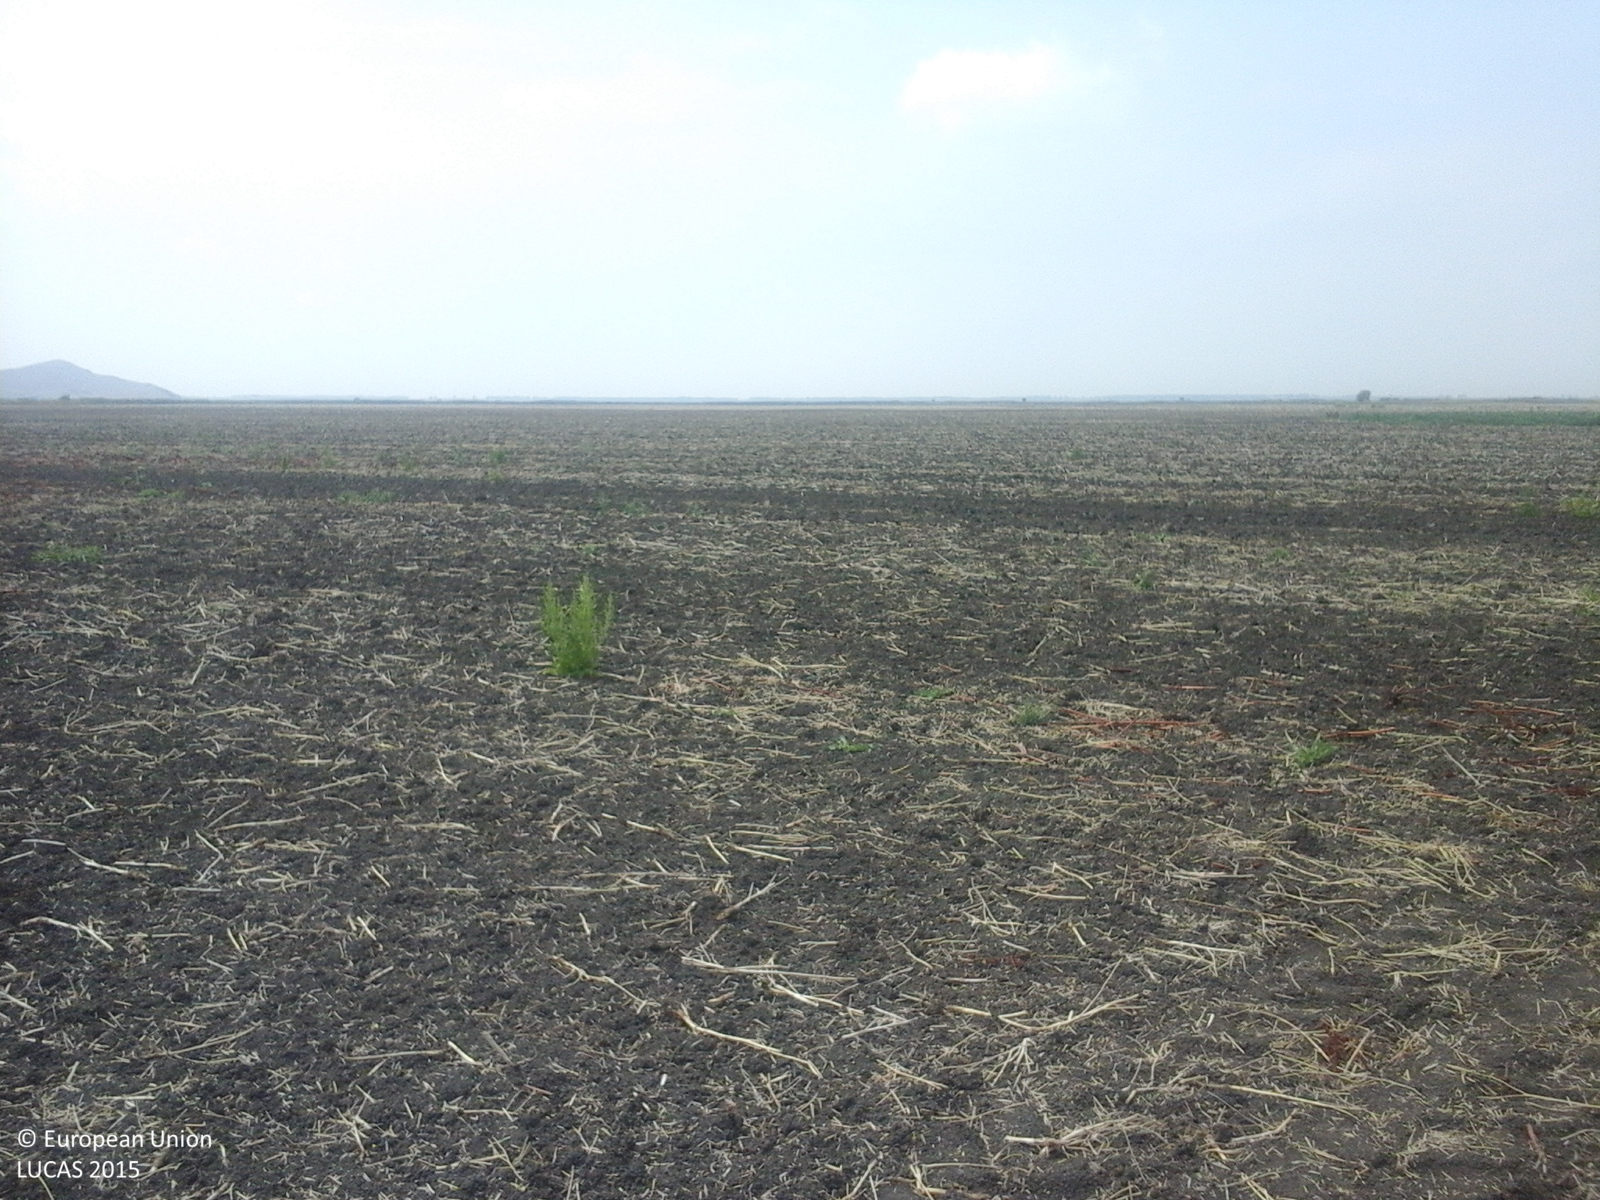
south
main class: Cropland
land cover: Rape and turnip rape
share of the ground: < 10 %
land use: Agriculture (excluding fallow land and kitchen gardens)
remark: Harvested field
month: July
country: RO
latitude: 45.3258
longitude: 28.0956
